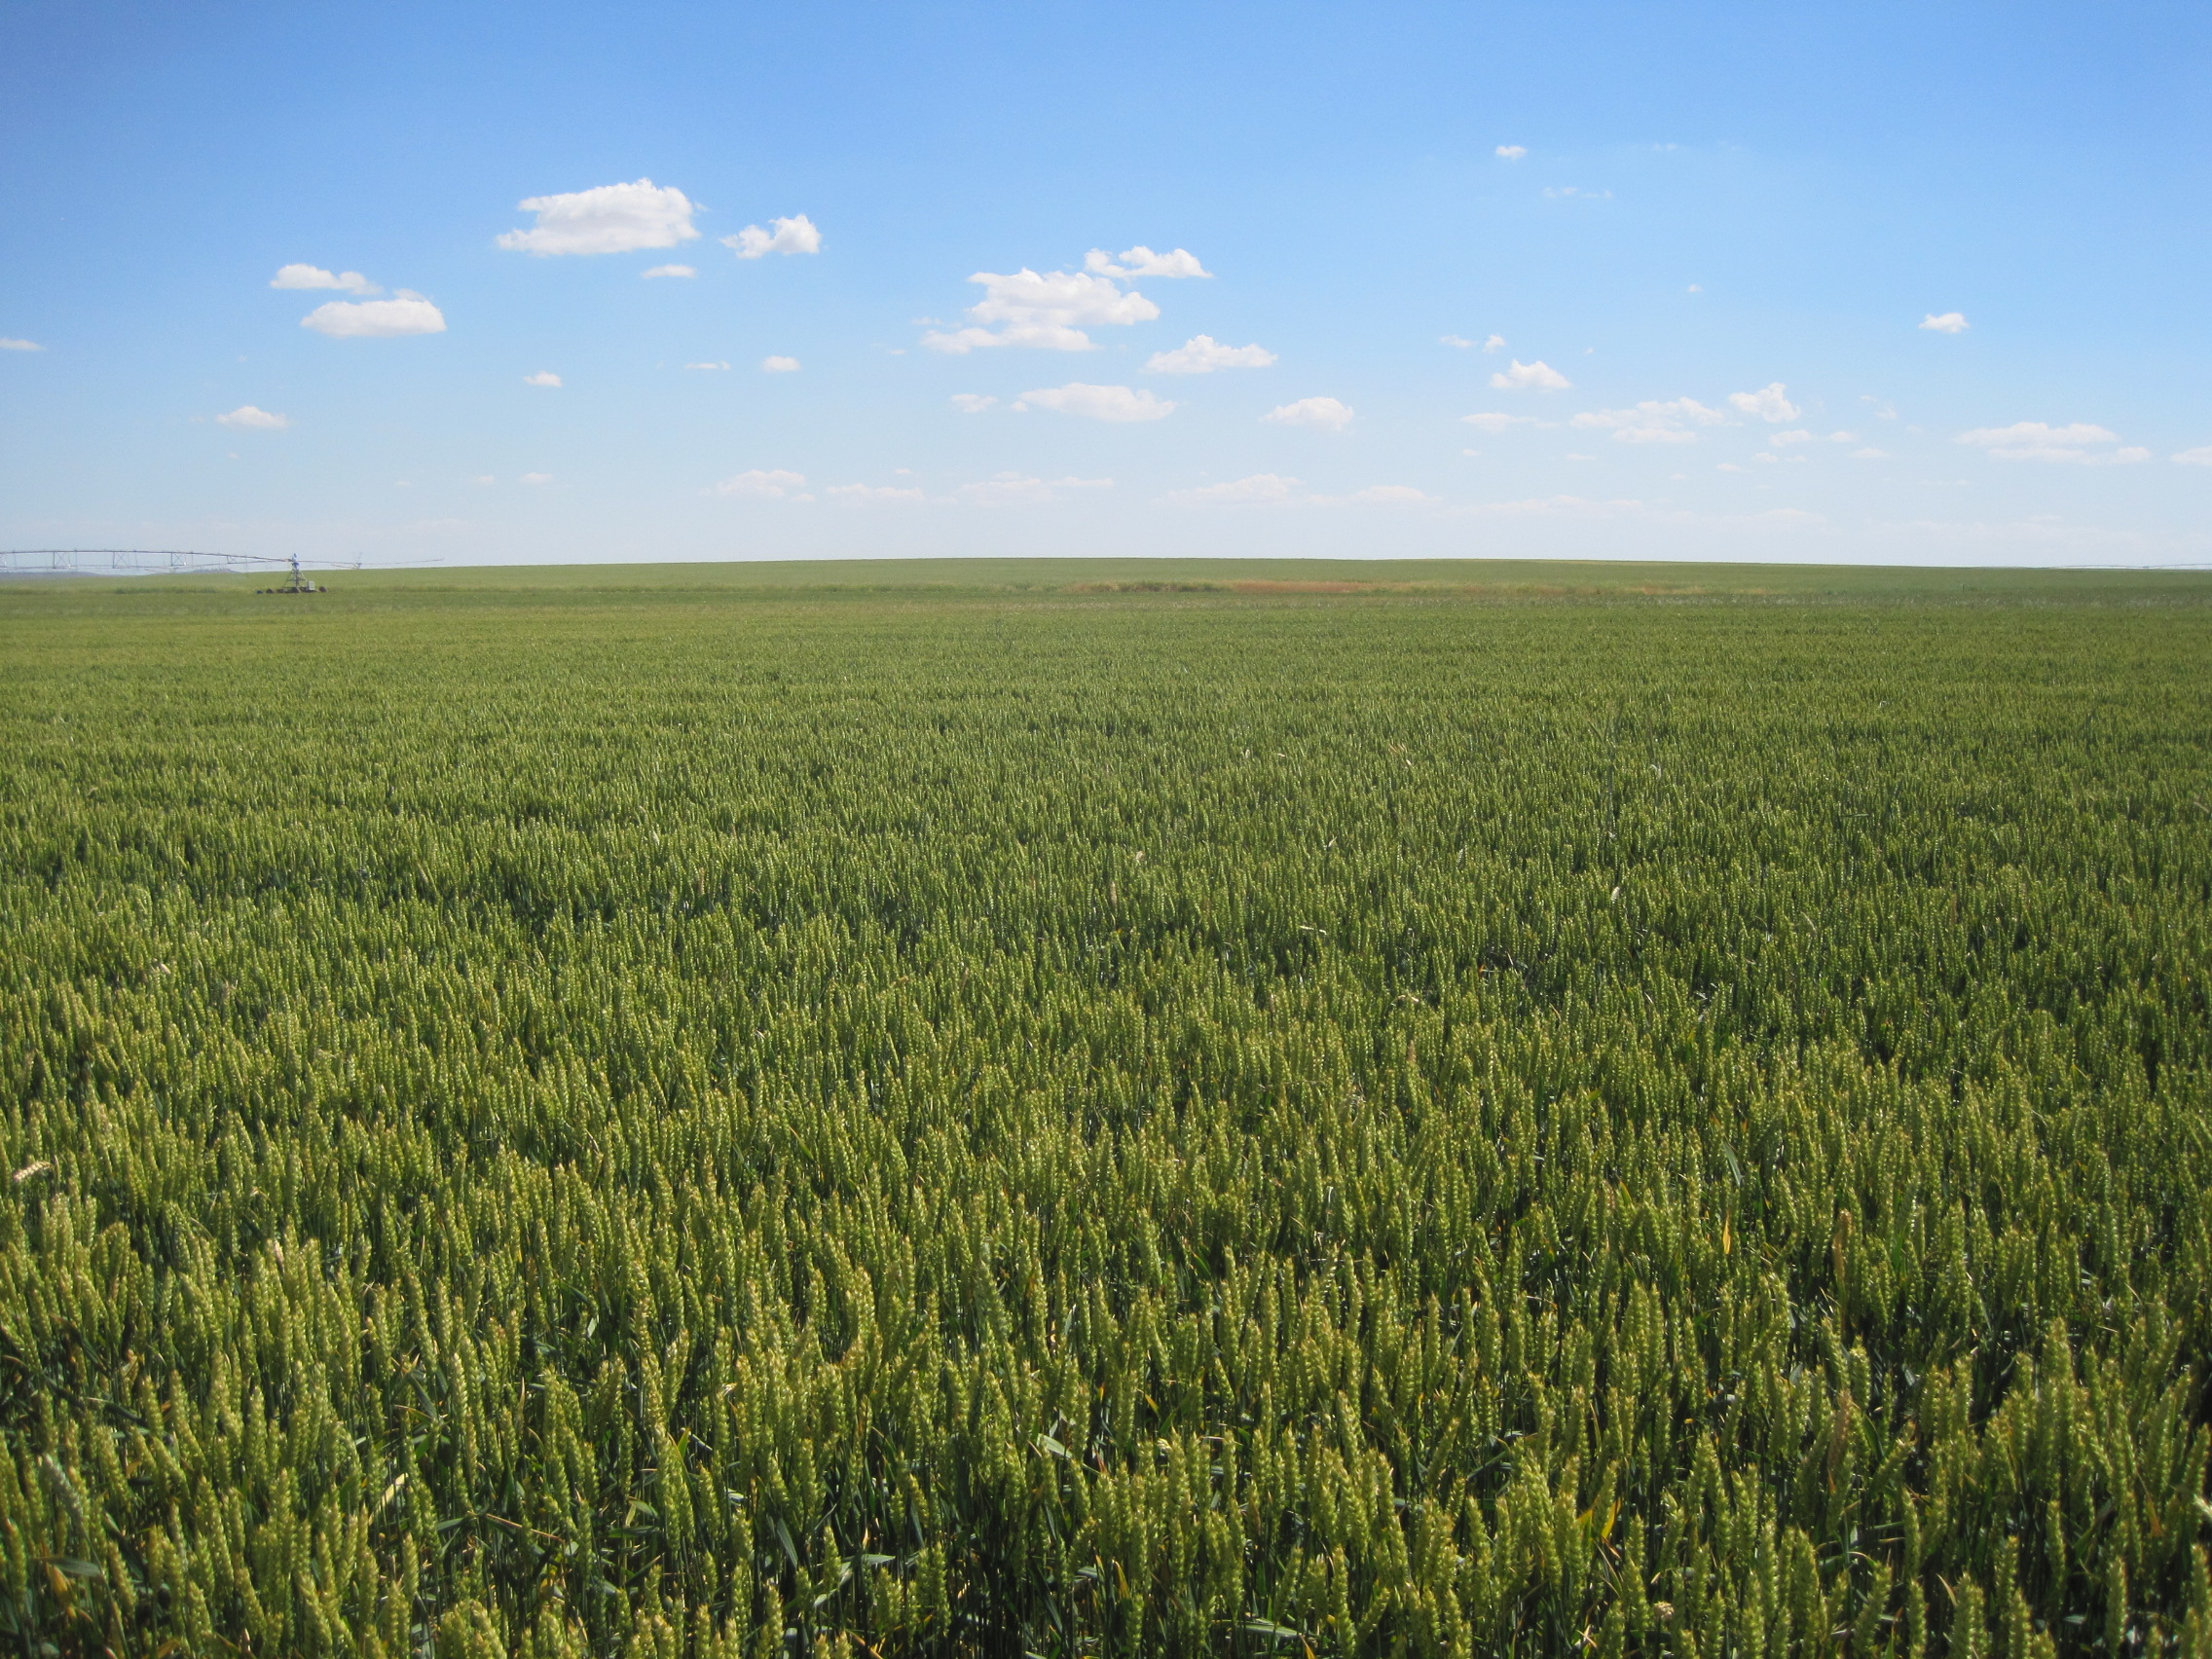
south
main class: Cropland
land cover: Common wheat
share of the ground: > 75 %
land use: Agriculture (excluding fallow land and kitchen gardens)
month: June
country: ES
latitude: 41.7662
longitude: -5.3712
